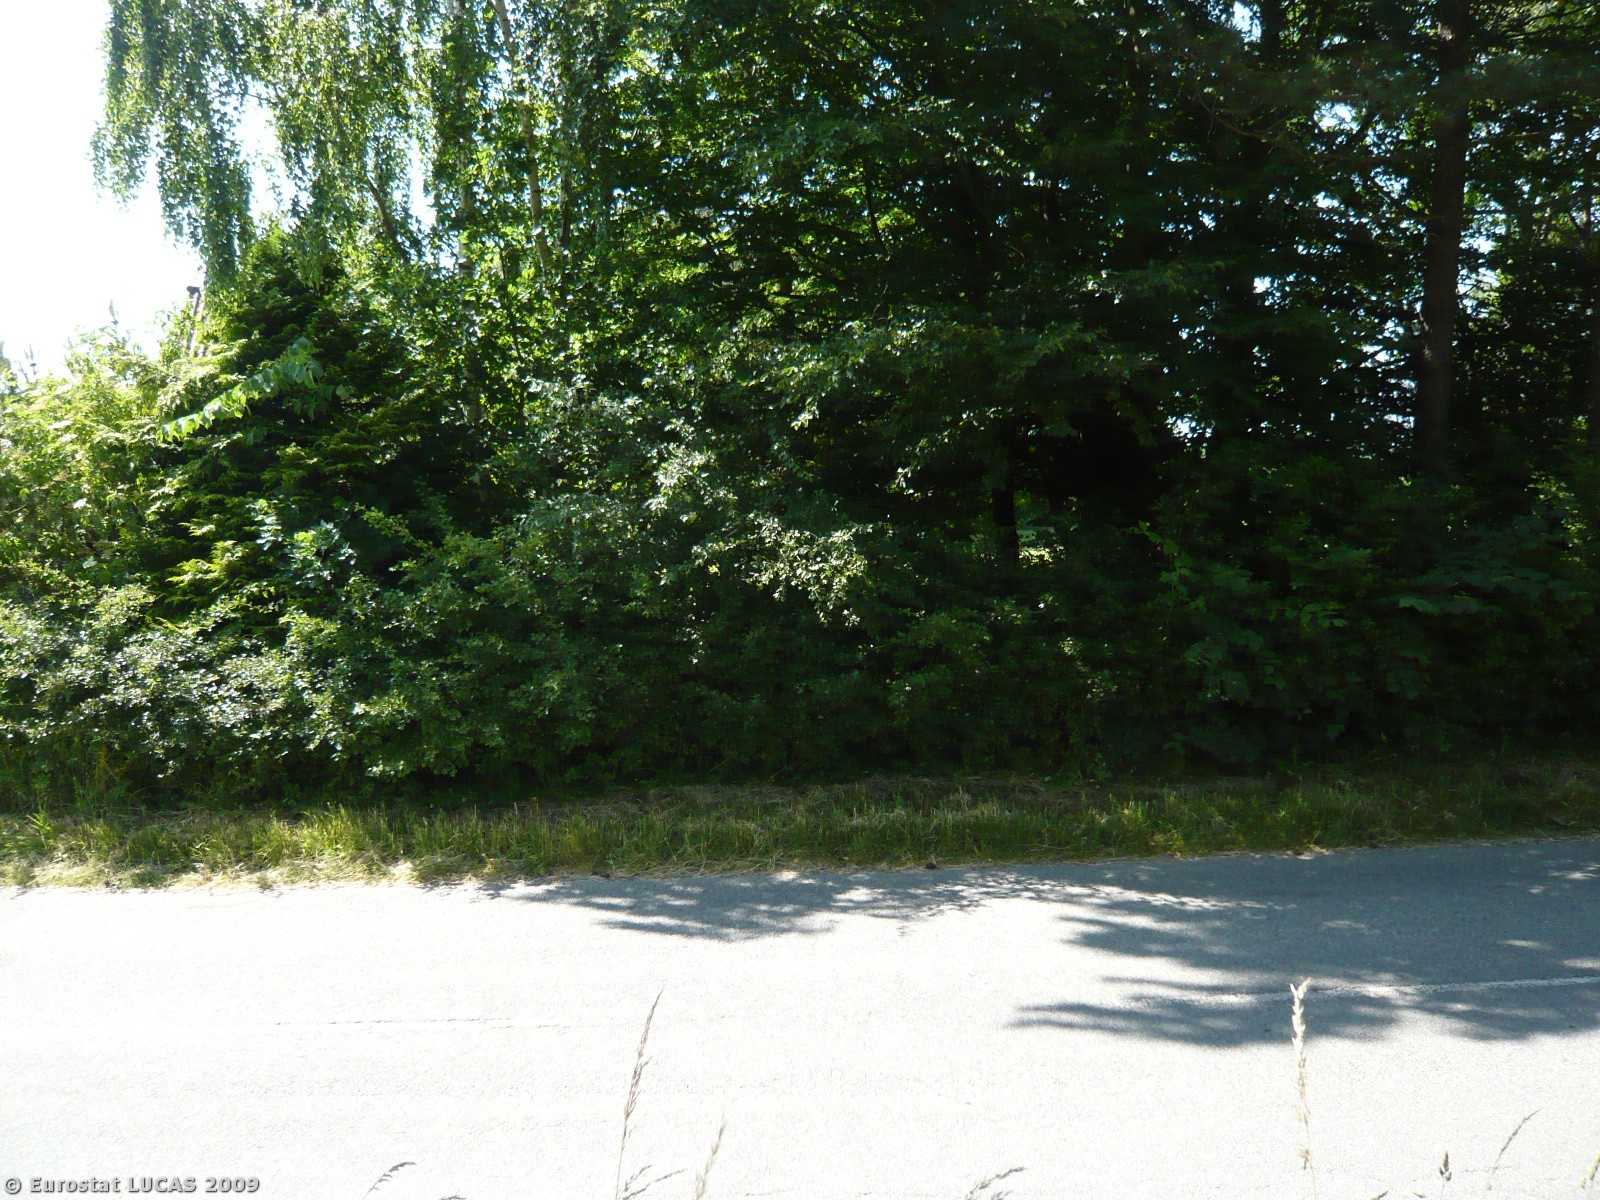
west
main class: Grassland
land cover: Spontaneously vegetated surfaces
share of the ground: > 75 %
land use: Fallow land
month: July
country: DK
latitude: 55.3788
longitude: 10.1734
